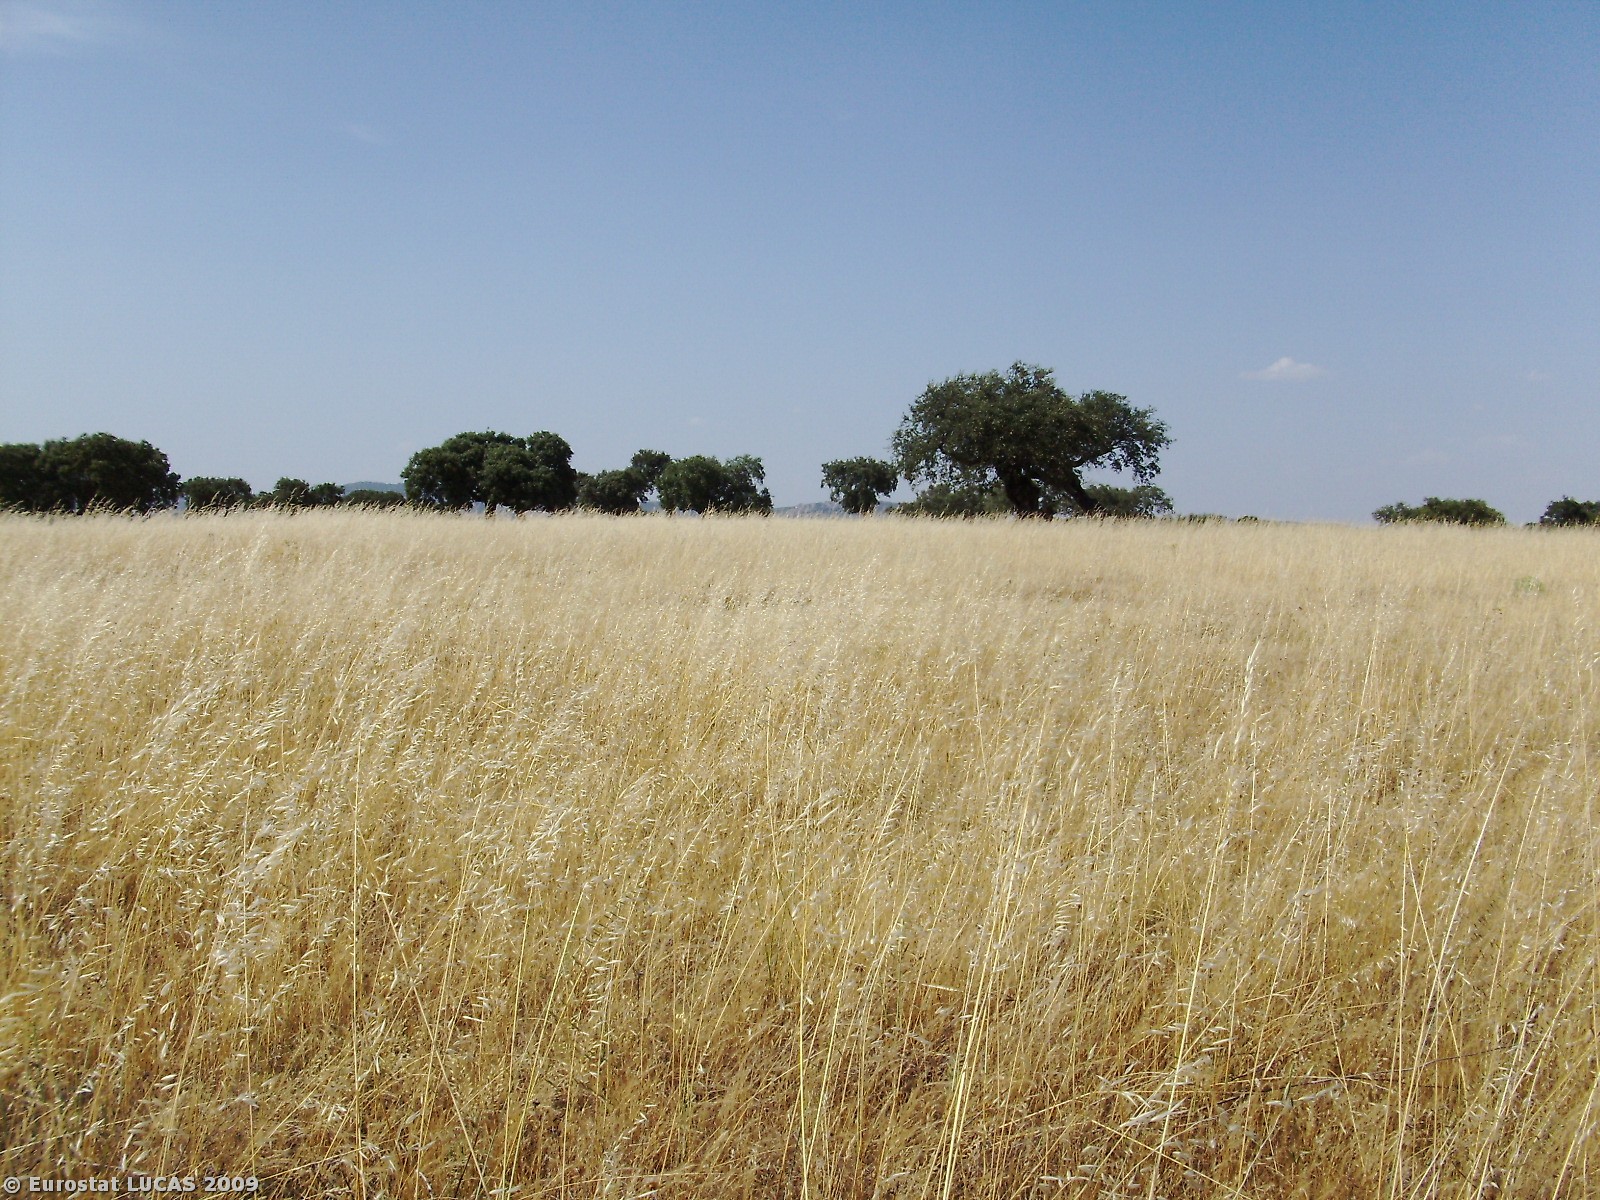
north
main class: Grassland
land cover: Grassland without tree/shrub cover
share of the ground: > 75 %
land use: Agriculture (excluding fallow land and kitchen gardens)
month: June
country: PT
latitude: 39.1171
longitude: -7.2320
